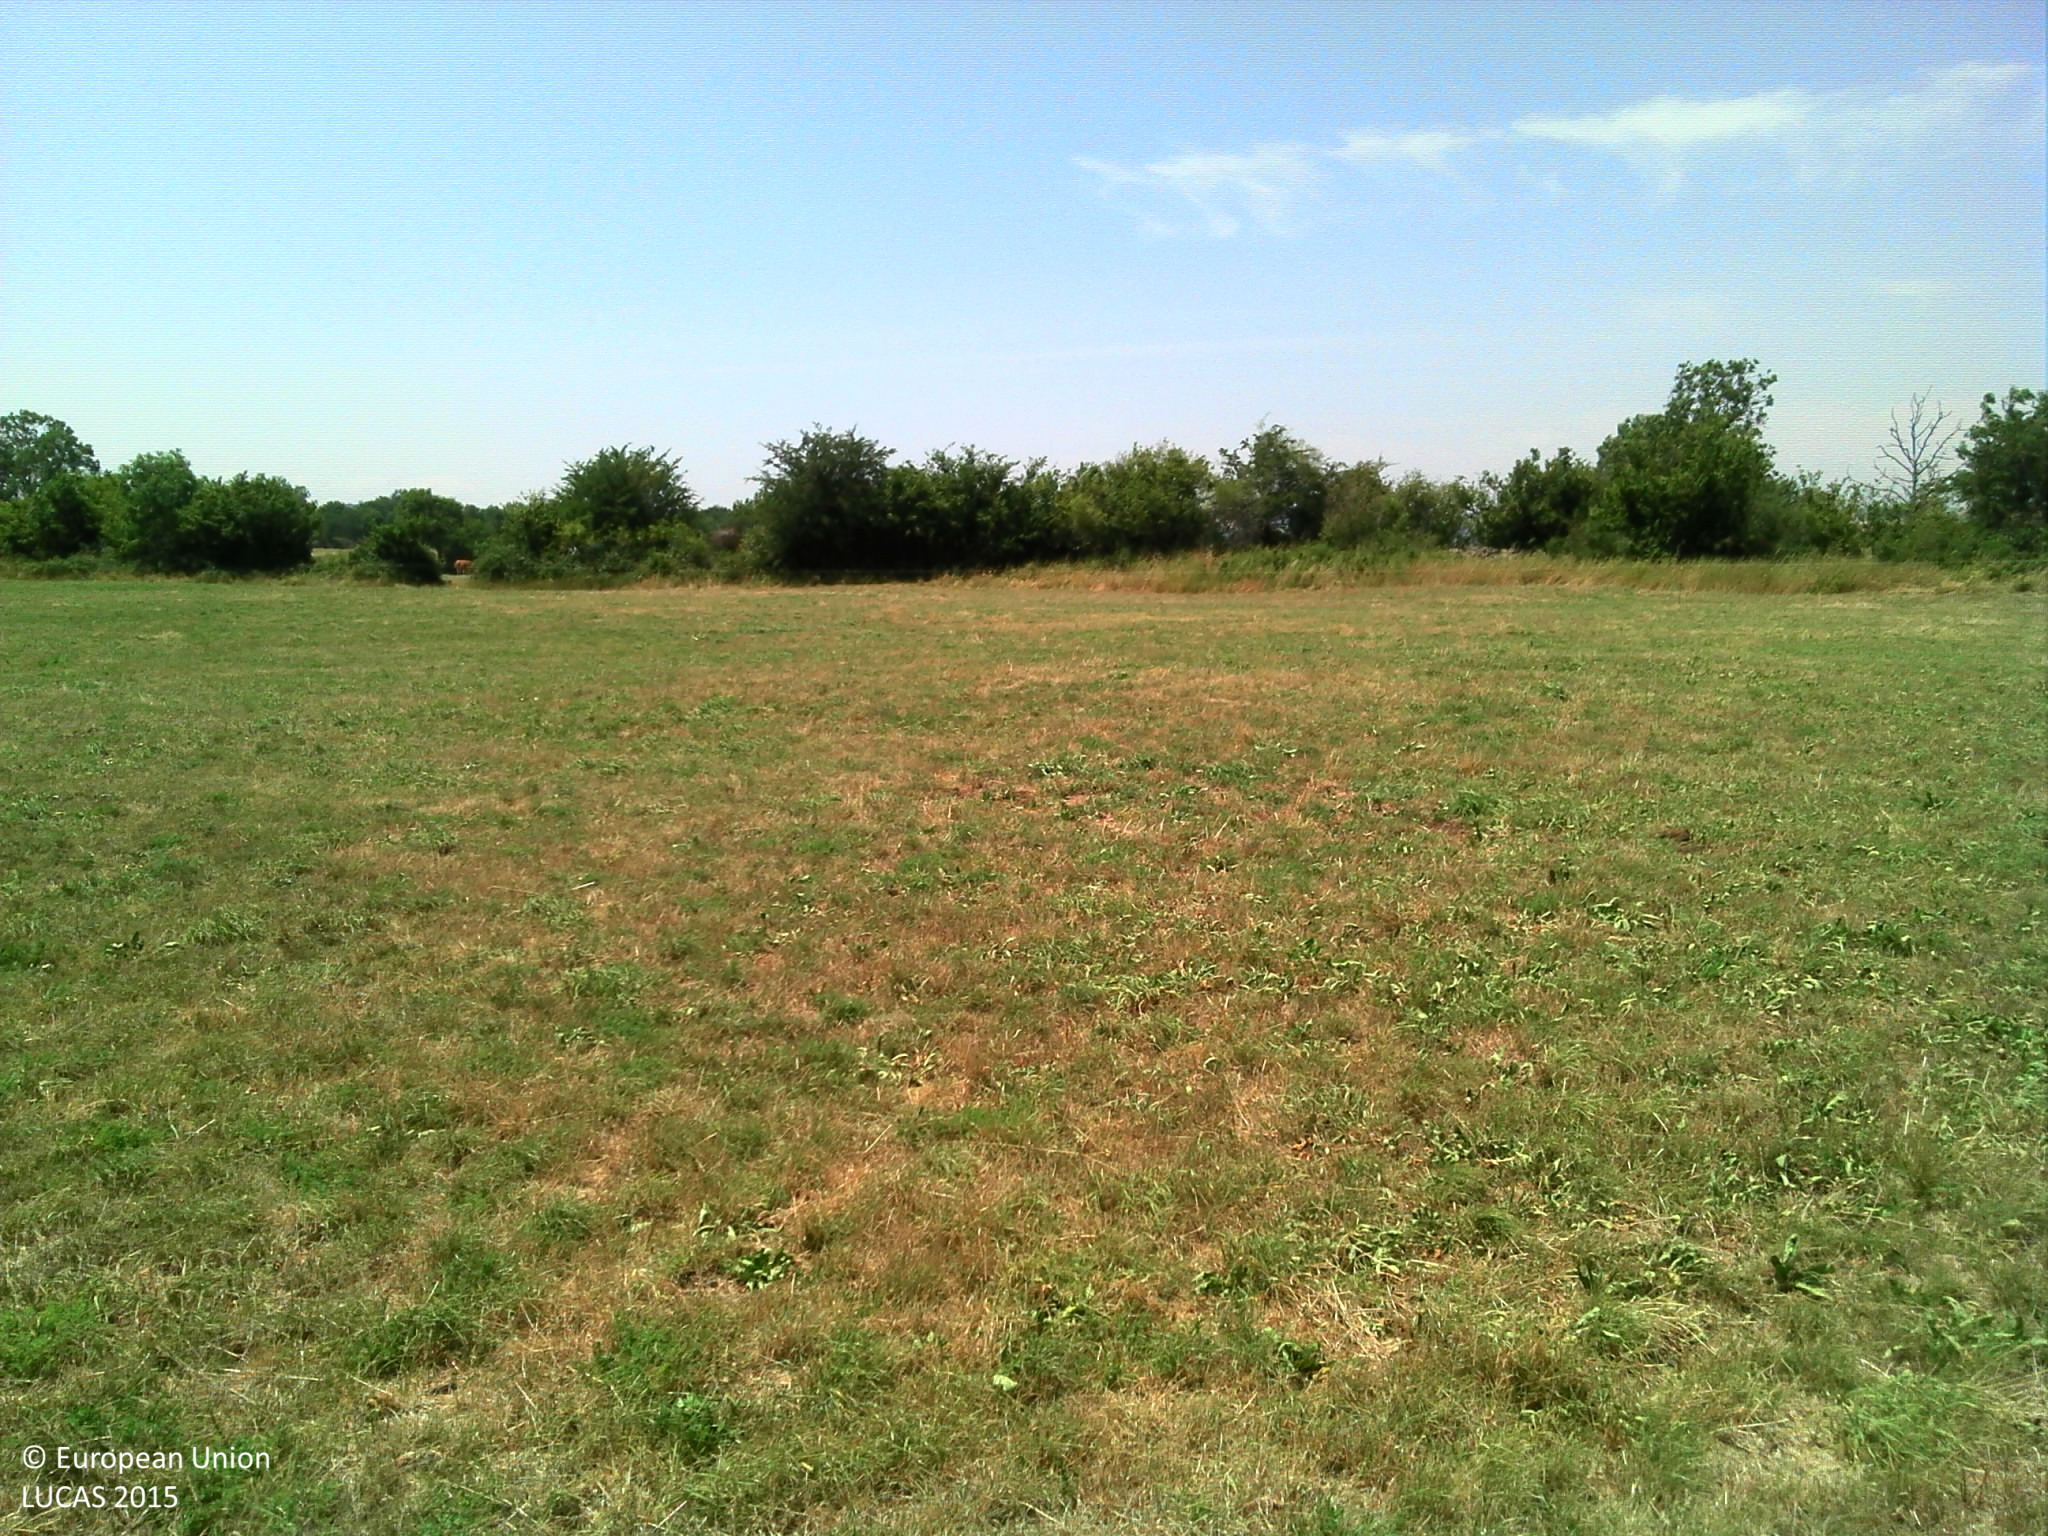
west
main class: Grassland
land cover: Grassland without tree/shrub cover
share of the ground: > 75 %
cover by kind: herbaceous plants 100 %
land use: Agriculture (excluding fallow land and kitchen gardens)
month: July
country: FR
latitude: 45.2071
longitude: 3.1138
